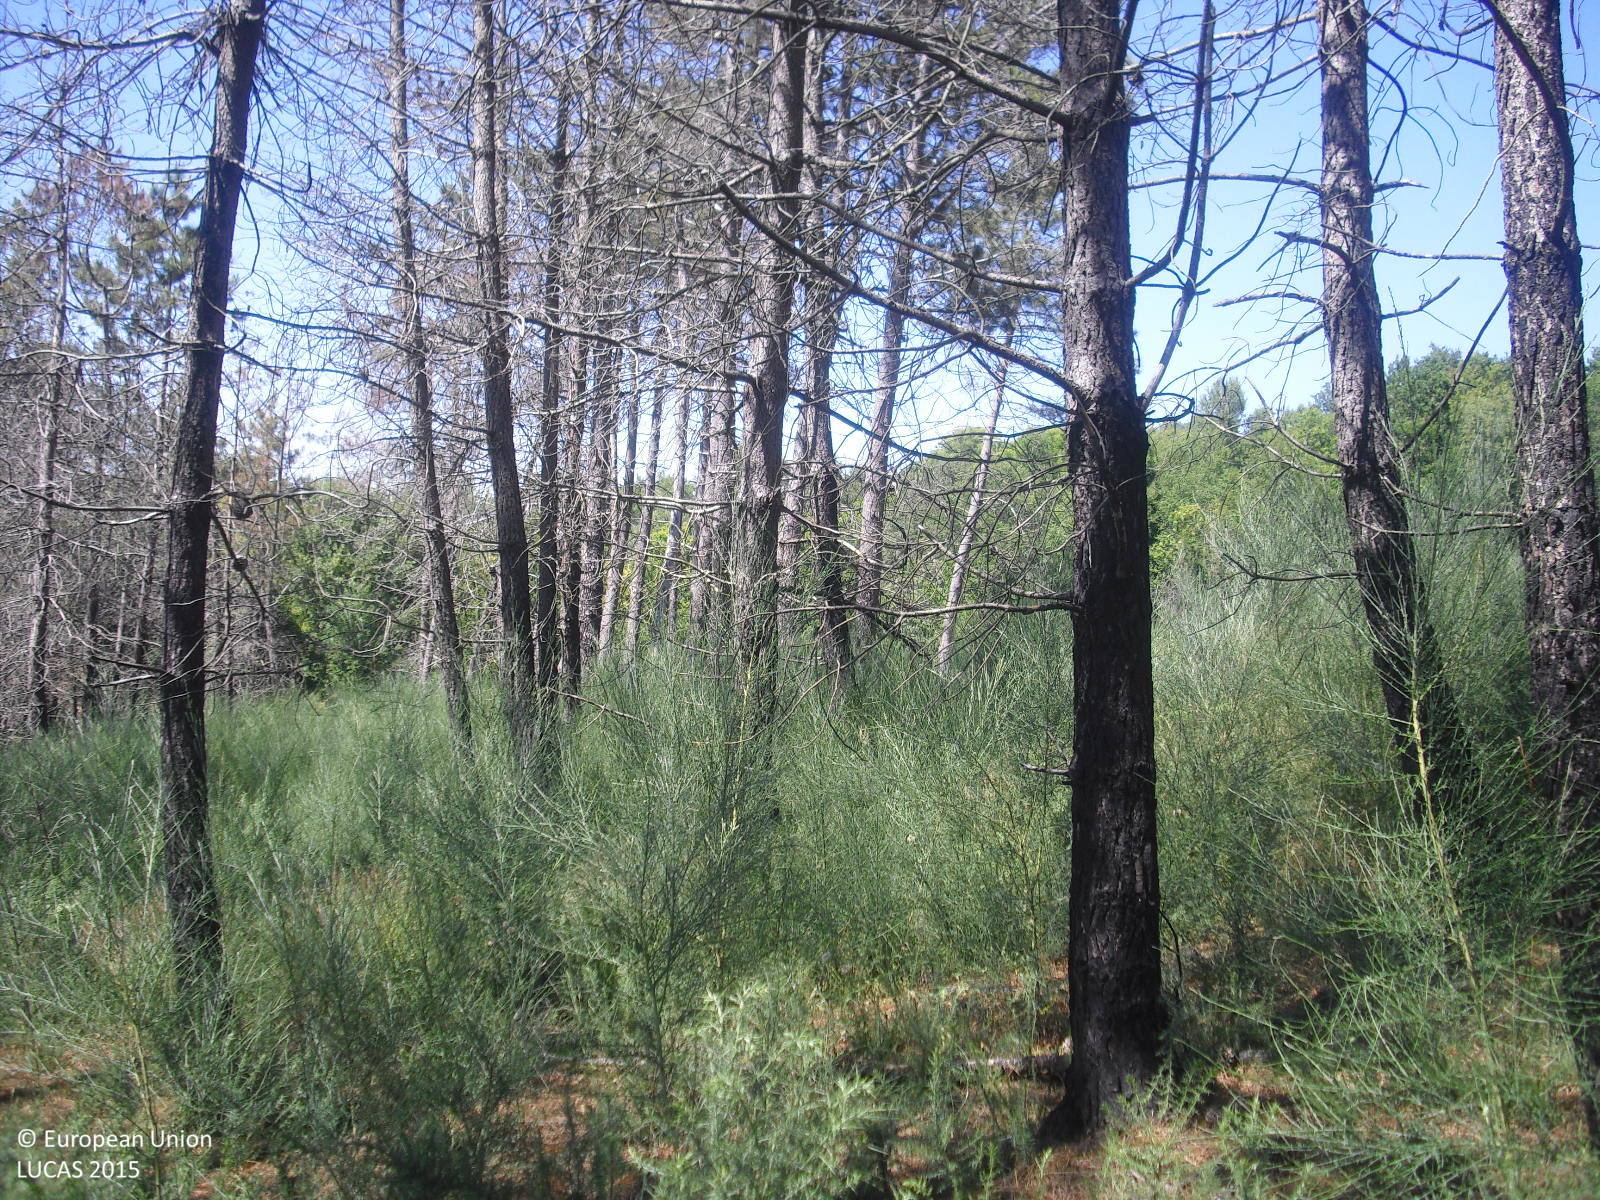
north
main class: Woodland
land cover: Pine dominated coniferous woodland
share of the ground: 10 - 25 %
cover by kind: shrubs 80 %, coniferous forest trees 20 %
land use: Forestry
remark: Burnt area
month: June
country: ES
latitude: 42.6270
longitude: -7.9213
